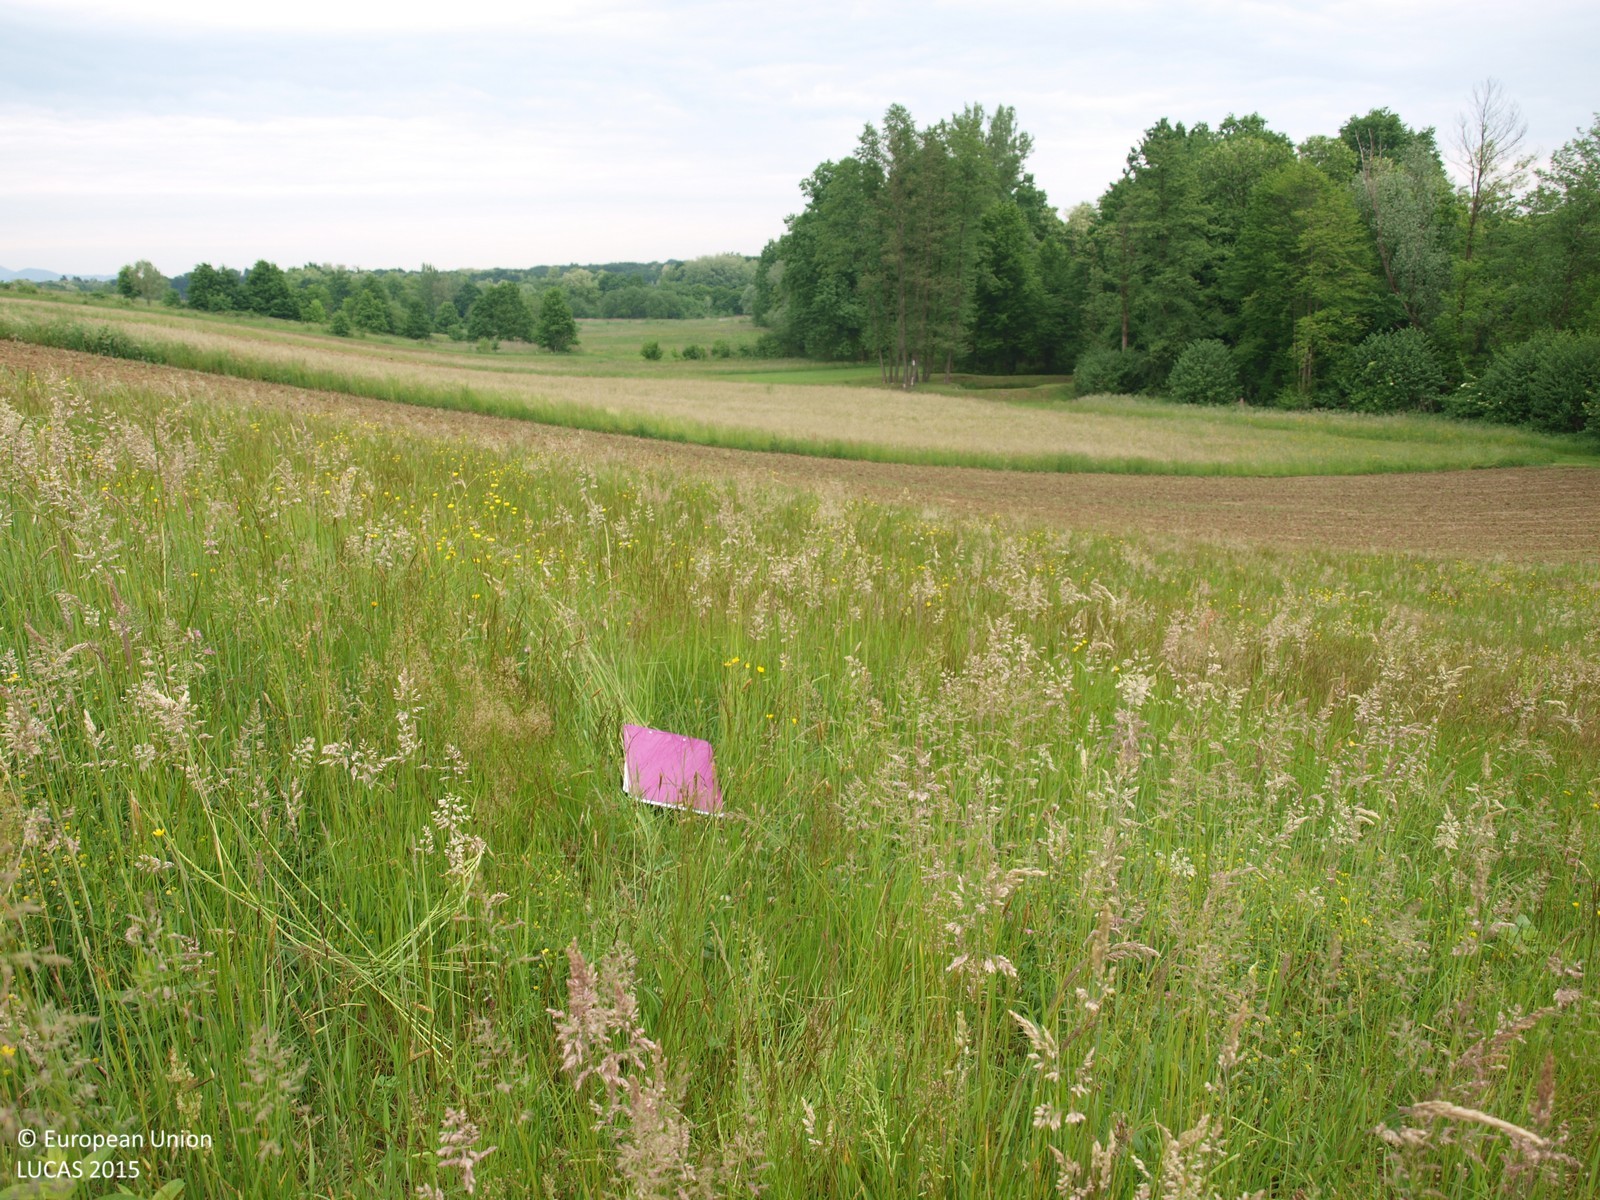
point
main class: Grassland
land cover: Grassland without tree/shrub cover
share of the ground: > 75 %
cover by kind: herbaceous plants 100 %
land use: Agriculture (excluding fallow land and kitchen gardens)
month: May
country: HR
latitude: 46.0650
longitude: 16.1655
